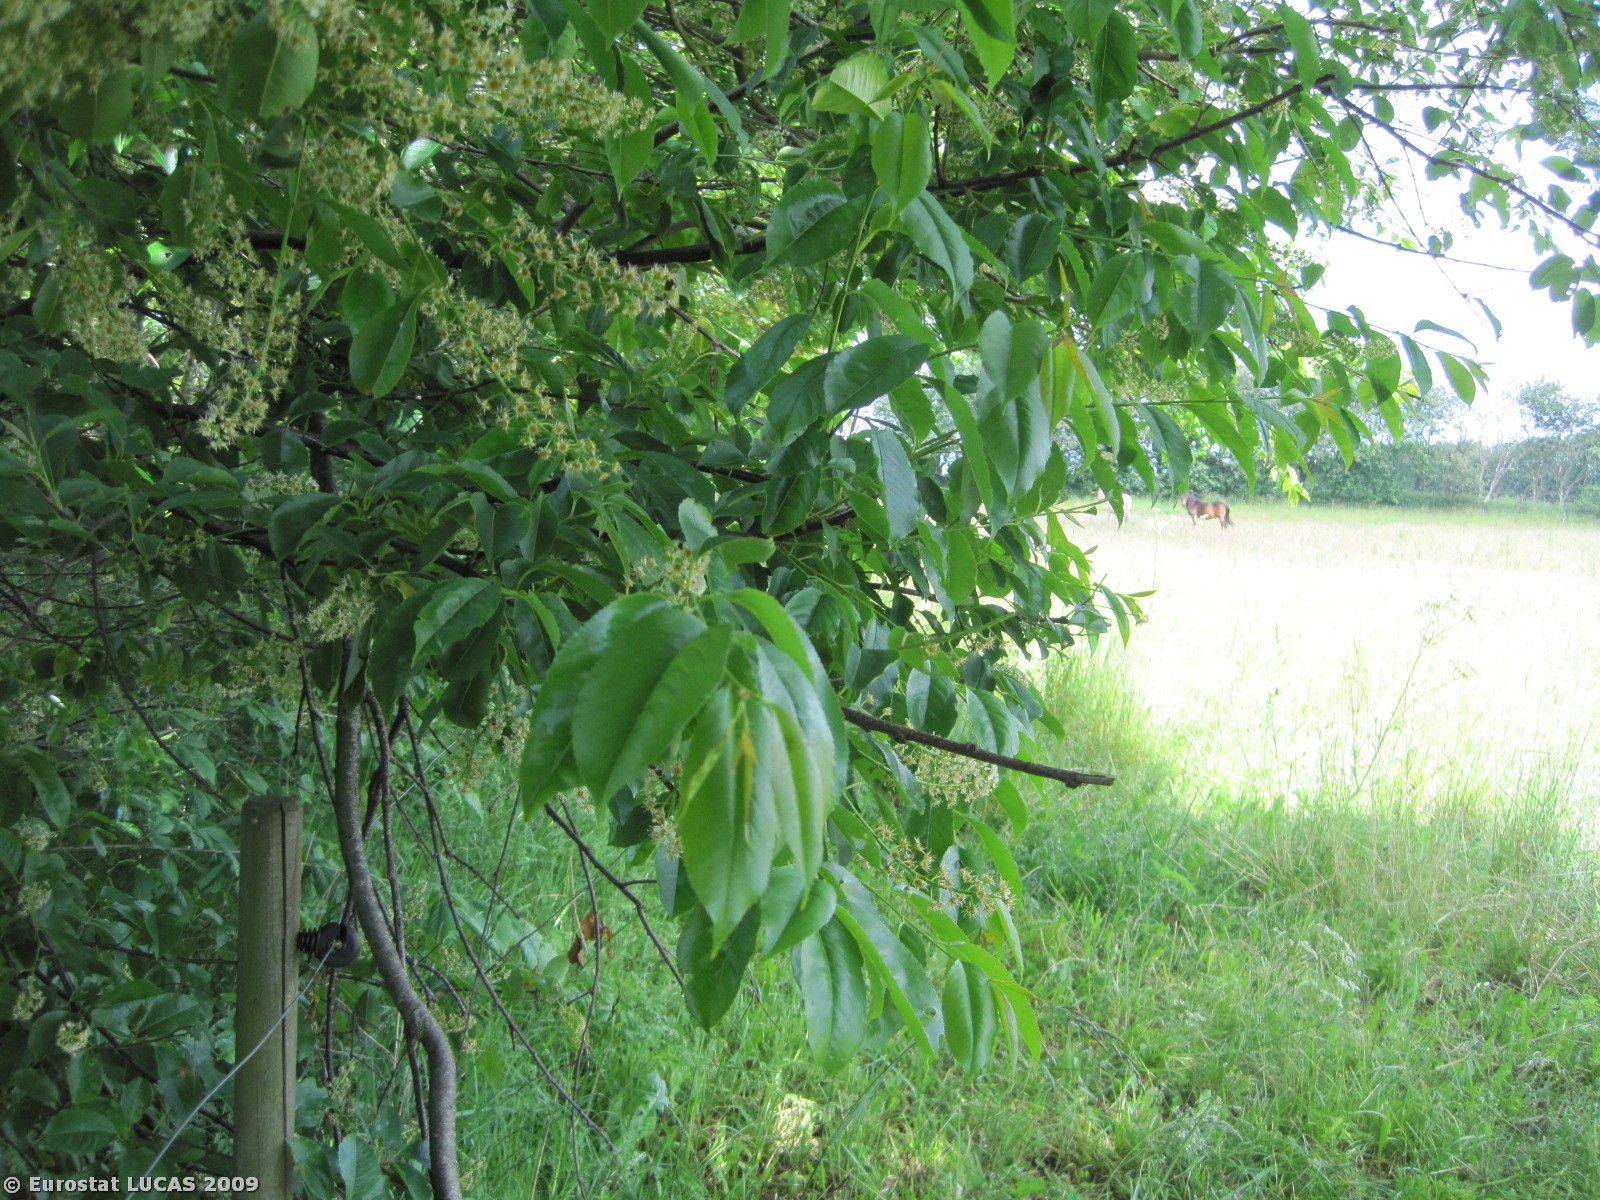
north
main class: Grassland
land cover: Grassland without tree/shrub cover
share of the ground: > 75 %
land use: Agriculture (excluding fallow land and kitchen gardens)
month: June
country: DK
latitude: 57.1403
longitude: 10.2145
